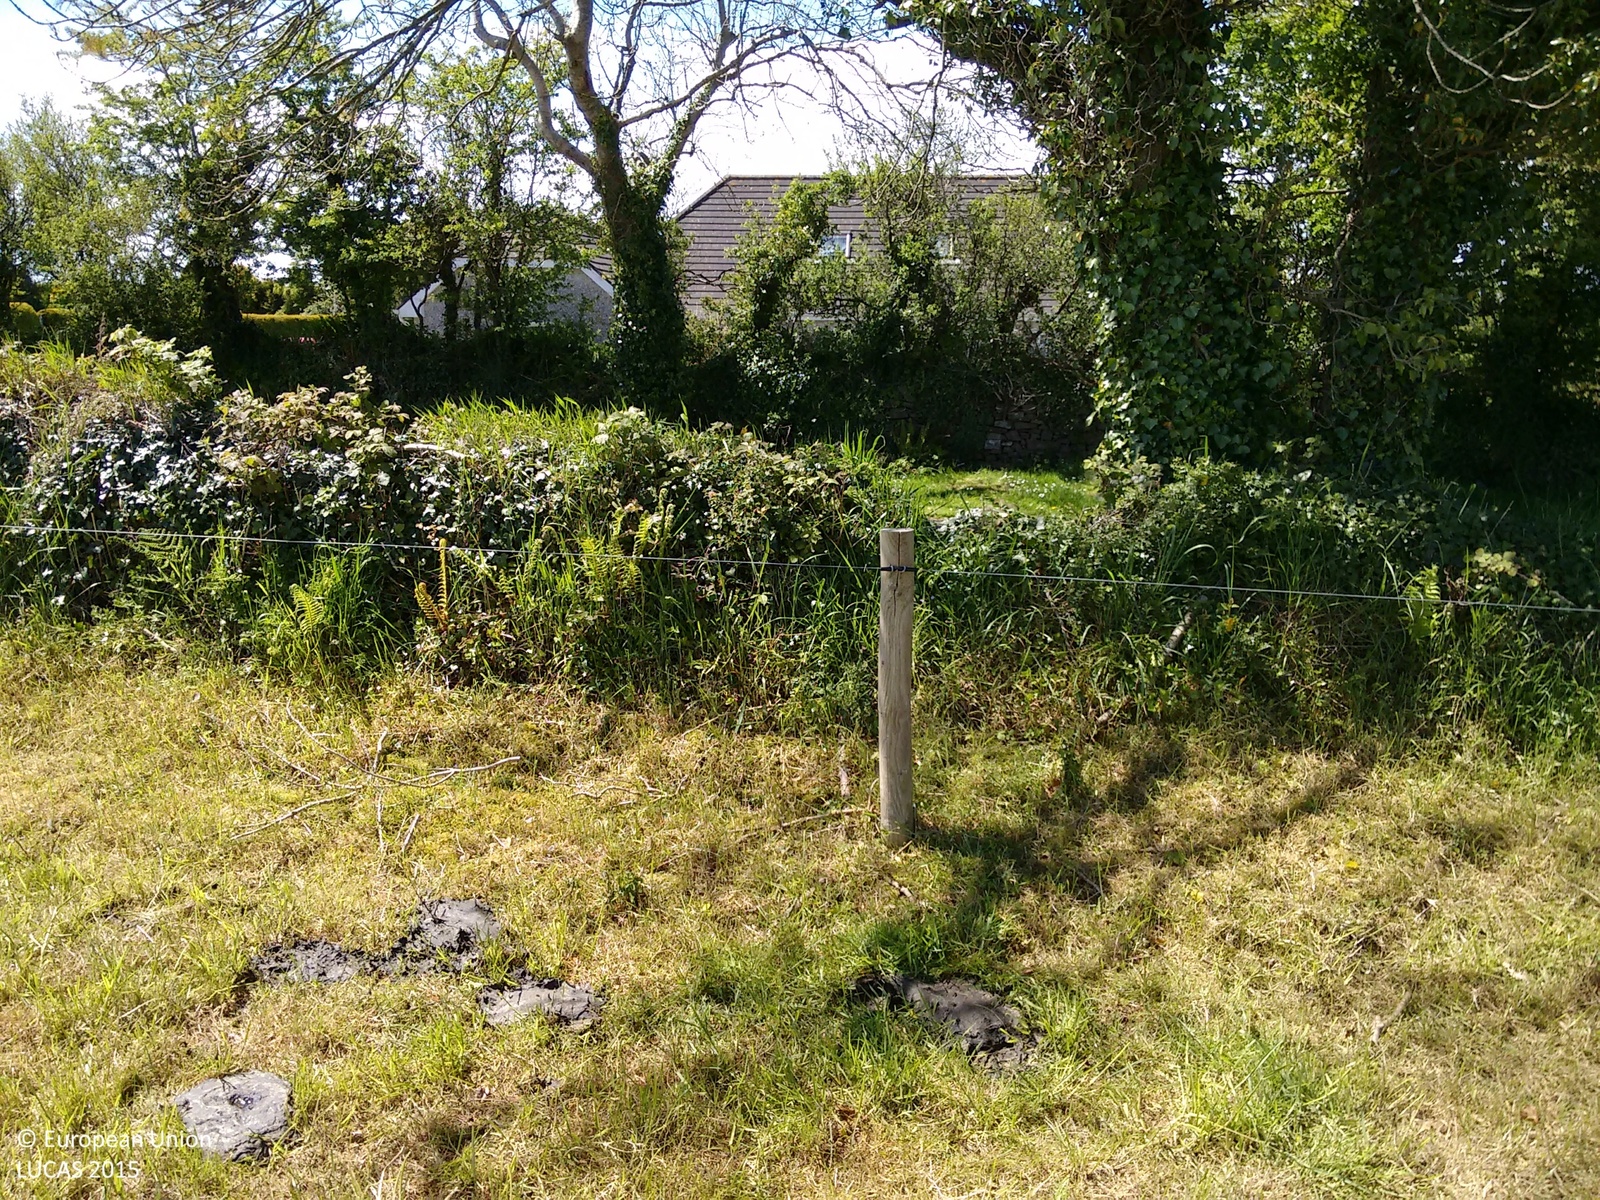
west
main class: Grassland
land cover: Grassland without tree/shrub cover
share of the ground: > 75 %
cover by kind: herbaceous plants 95 %, shrubs 5 %
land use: Agriculture (excluding fallow land and kitchen gardens)
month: May
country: IE
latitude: 51.9301
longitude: -8.3228
